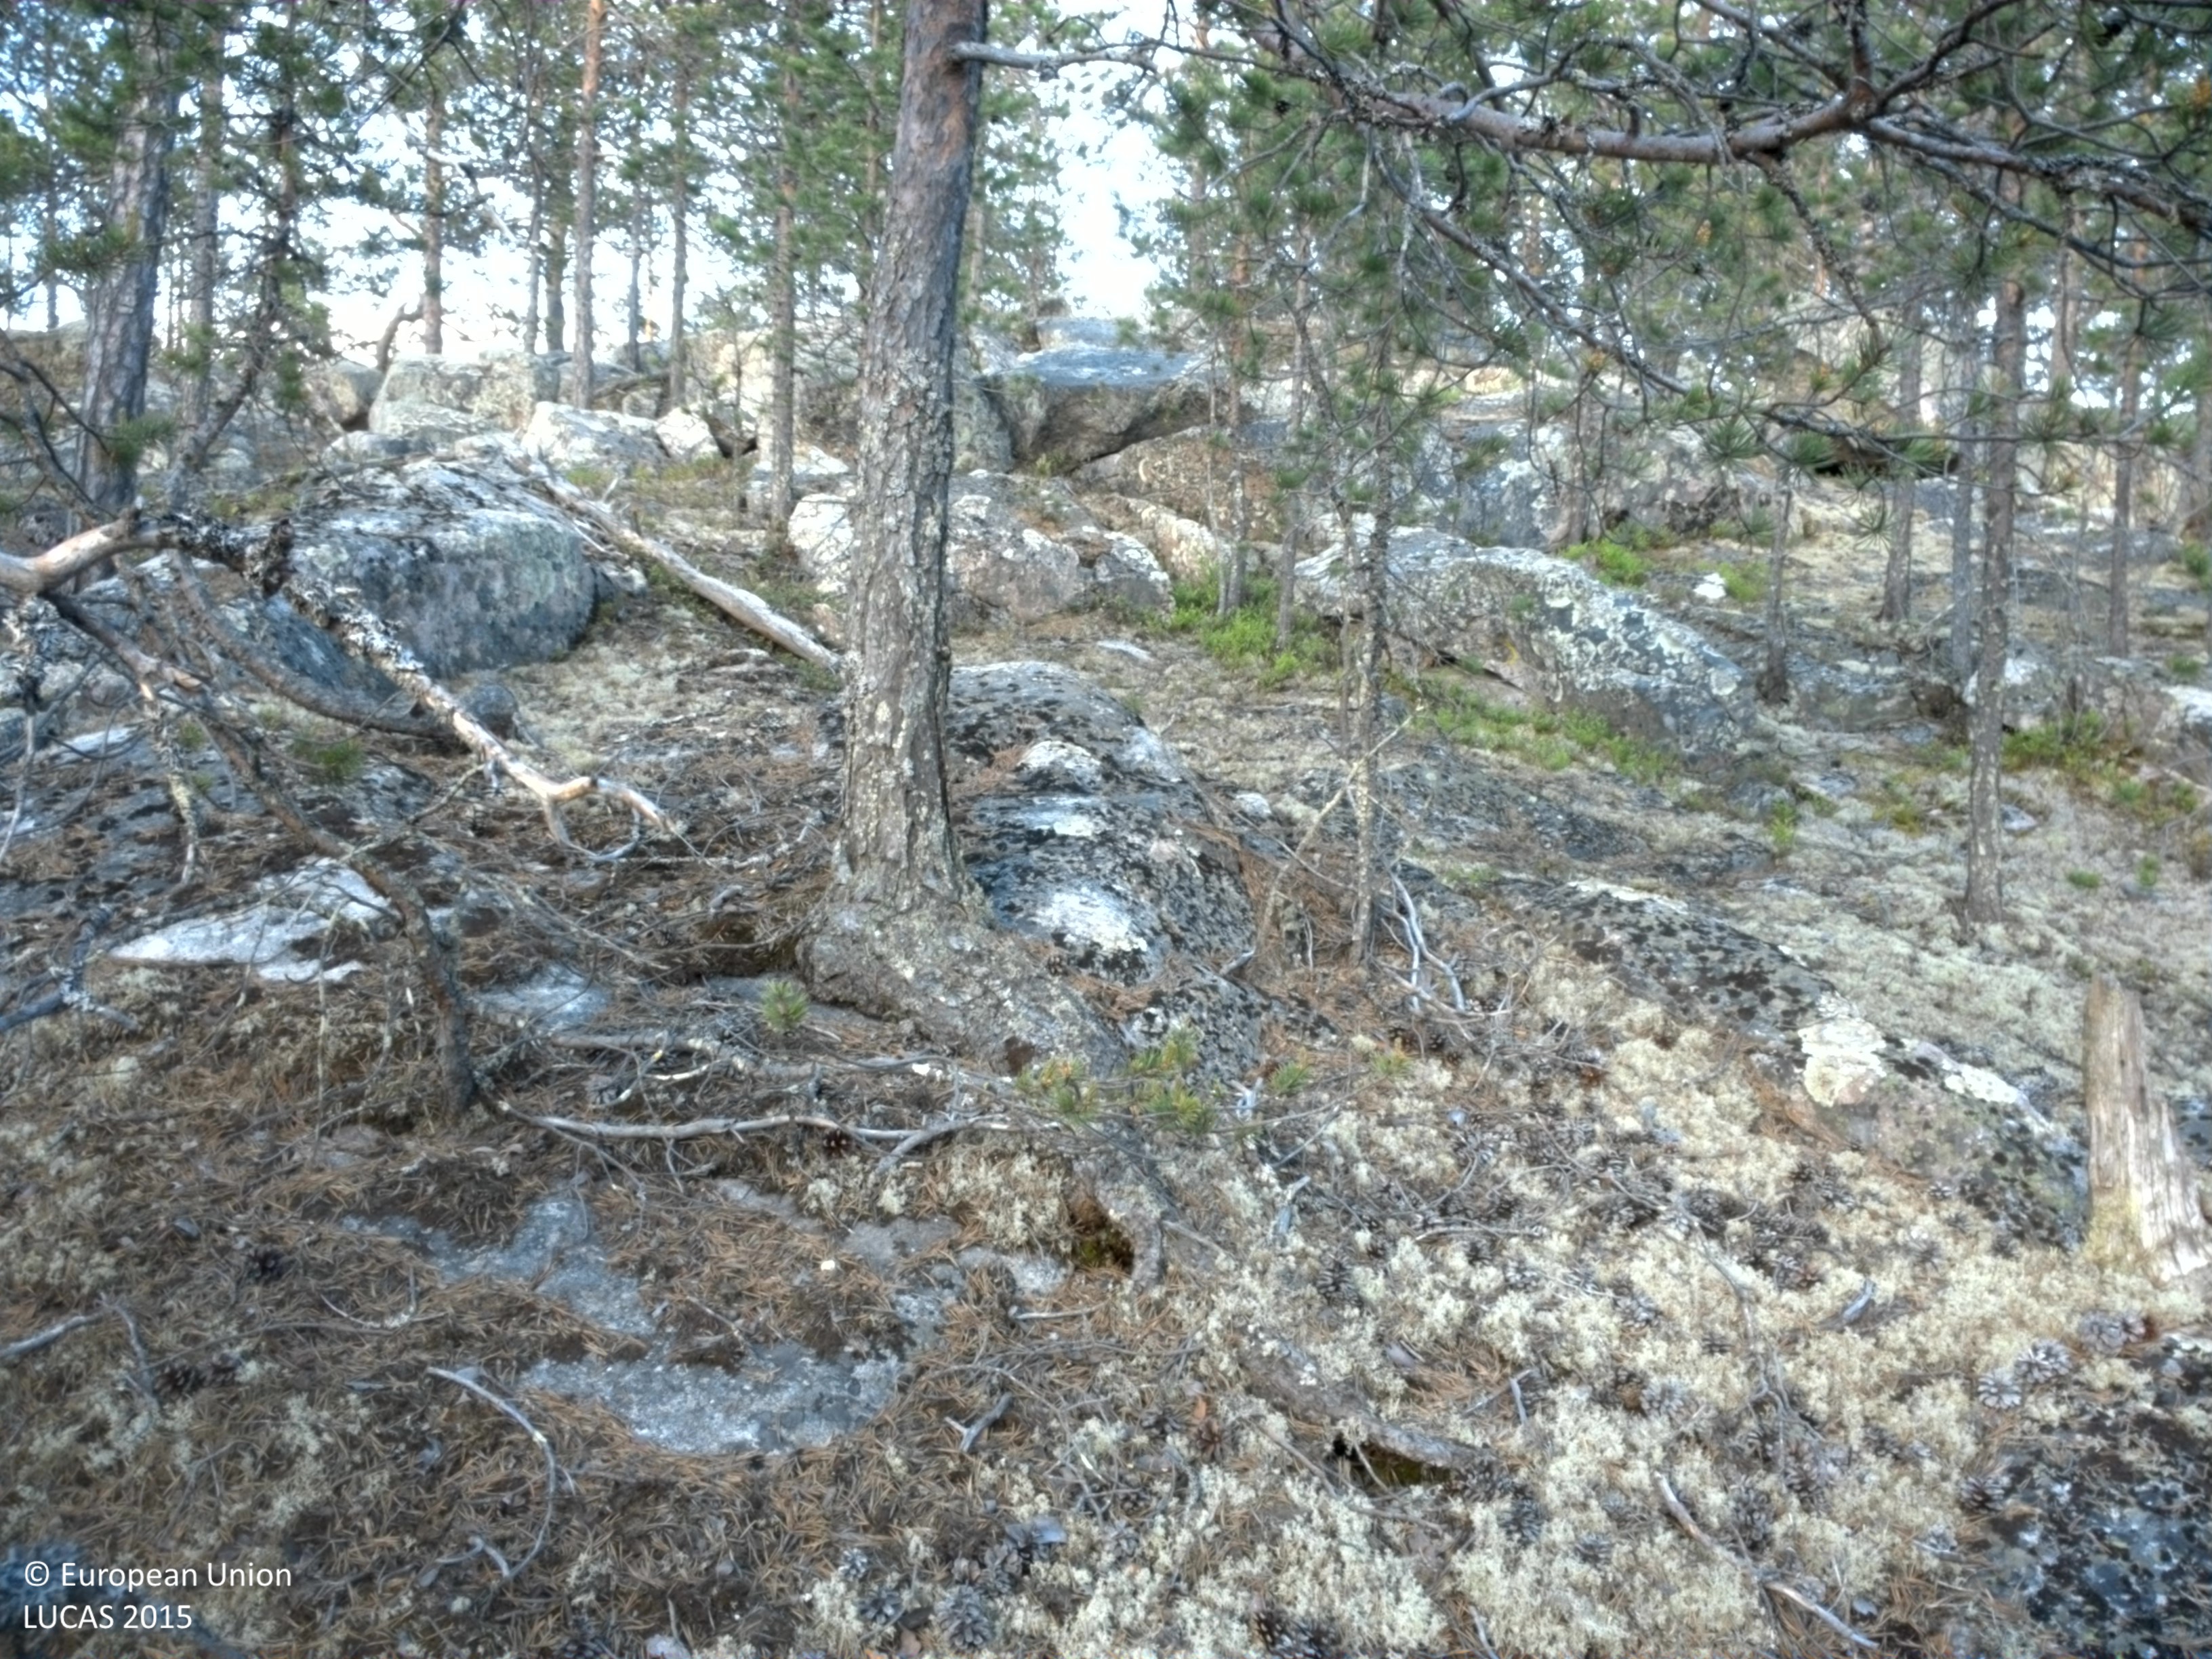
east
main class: Woodland
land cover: Pine dominated coniferous woodland
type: boreal forest
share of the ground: 10 - 25 %
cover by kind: consolidated bare surface 60 %, coniferous forest trees 20 %, lichens and mosses 15 %, shrubs 5 %
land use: Semi-natural and natural areas not in use
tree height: > 5 m
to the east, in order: Pine dominated coniferous woodland; Rocks and stones; Pine dominated coniferous woodland; Rocks and stones; Shrubland with sparse tree cover; Pine dominated coniferous woodland; Shrubland with sparse tree cover; Spruce dominated coniferous woodland; Shrubland with sparse tree cover
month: June
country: SE
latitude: 66.3163
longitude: 22.8509
